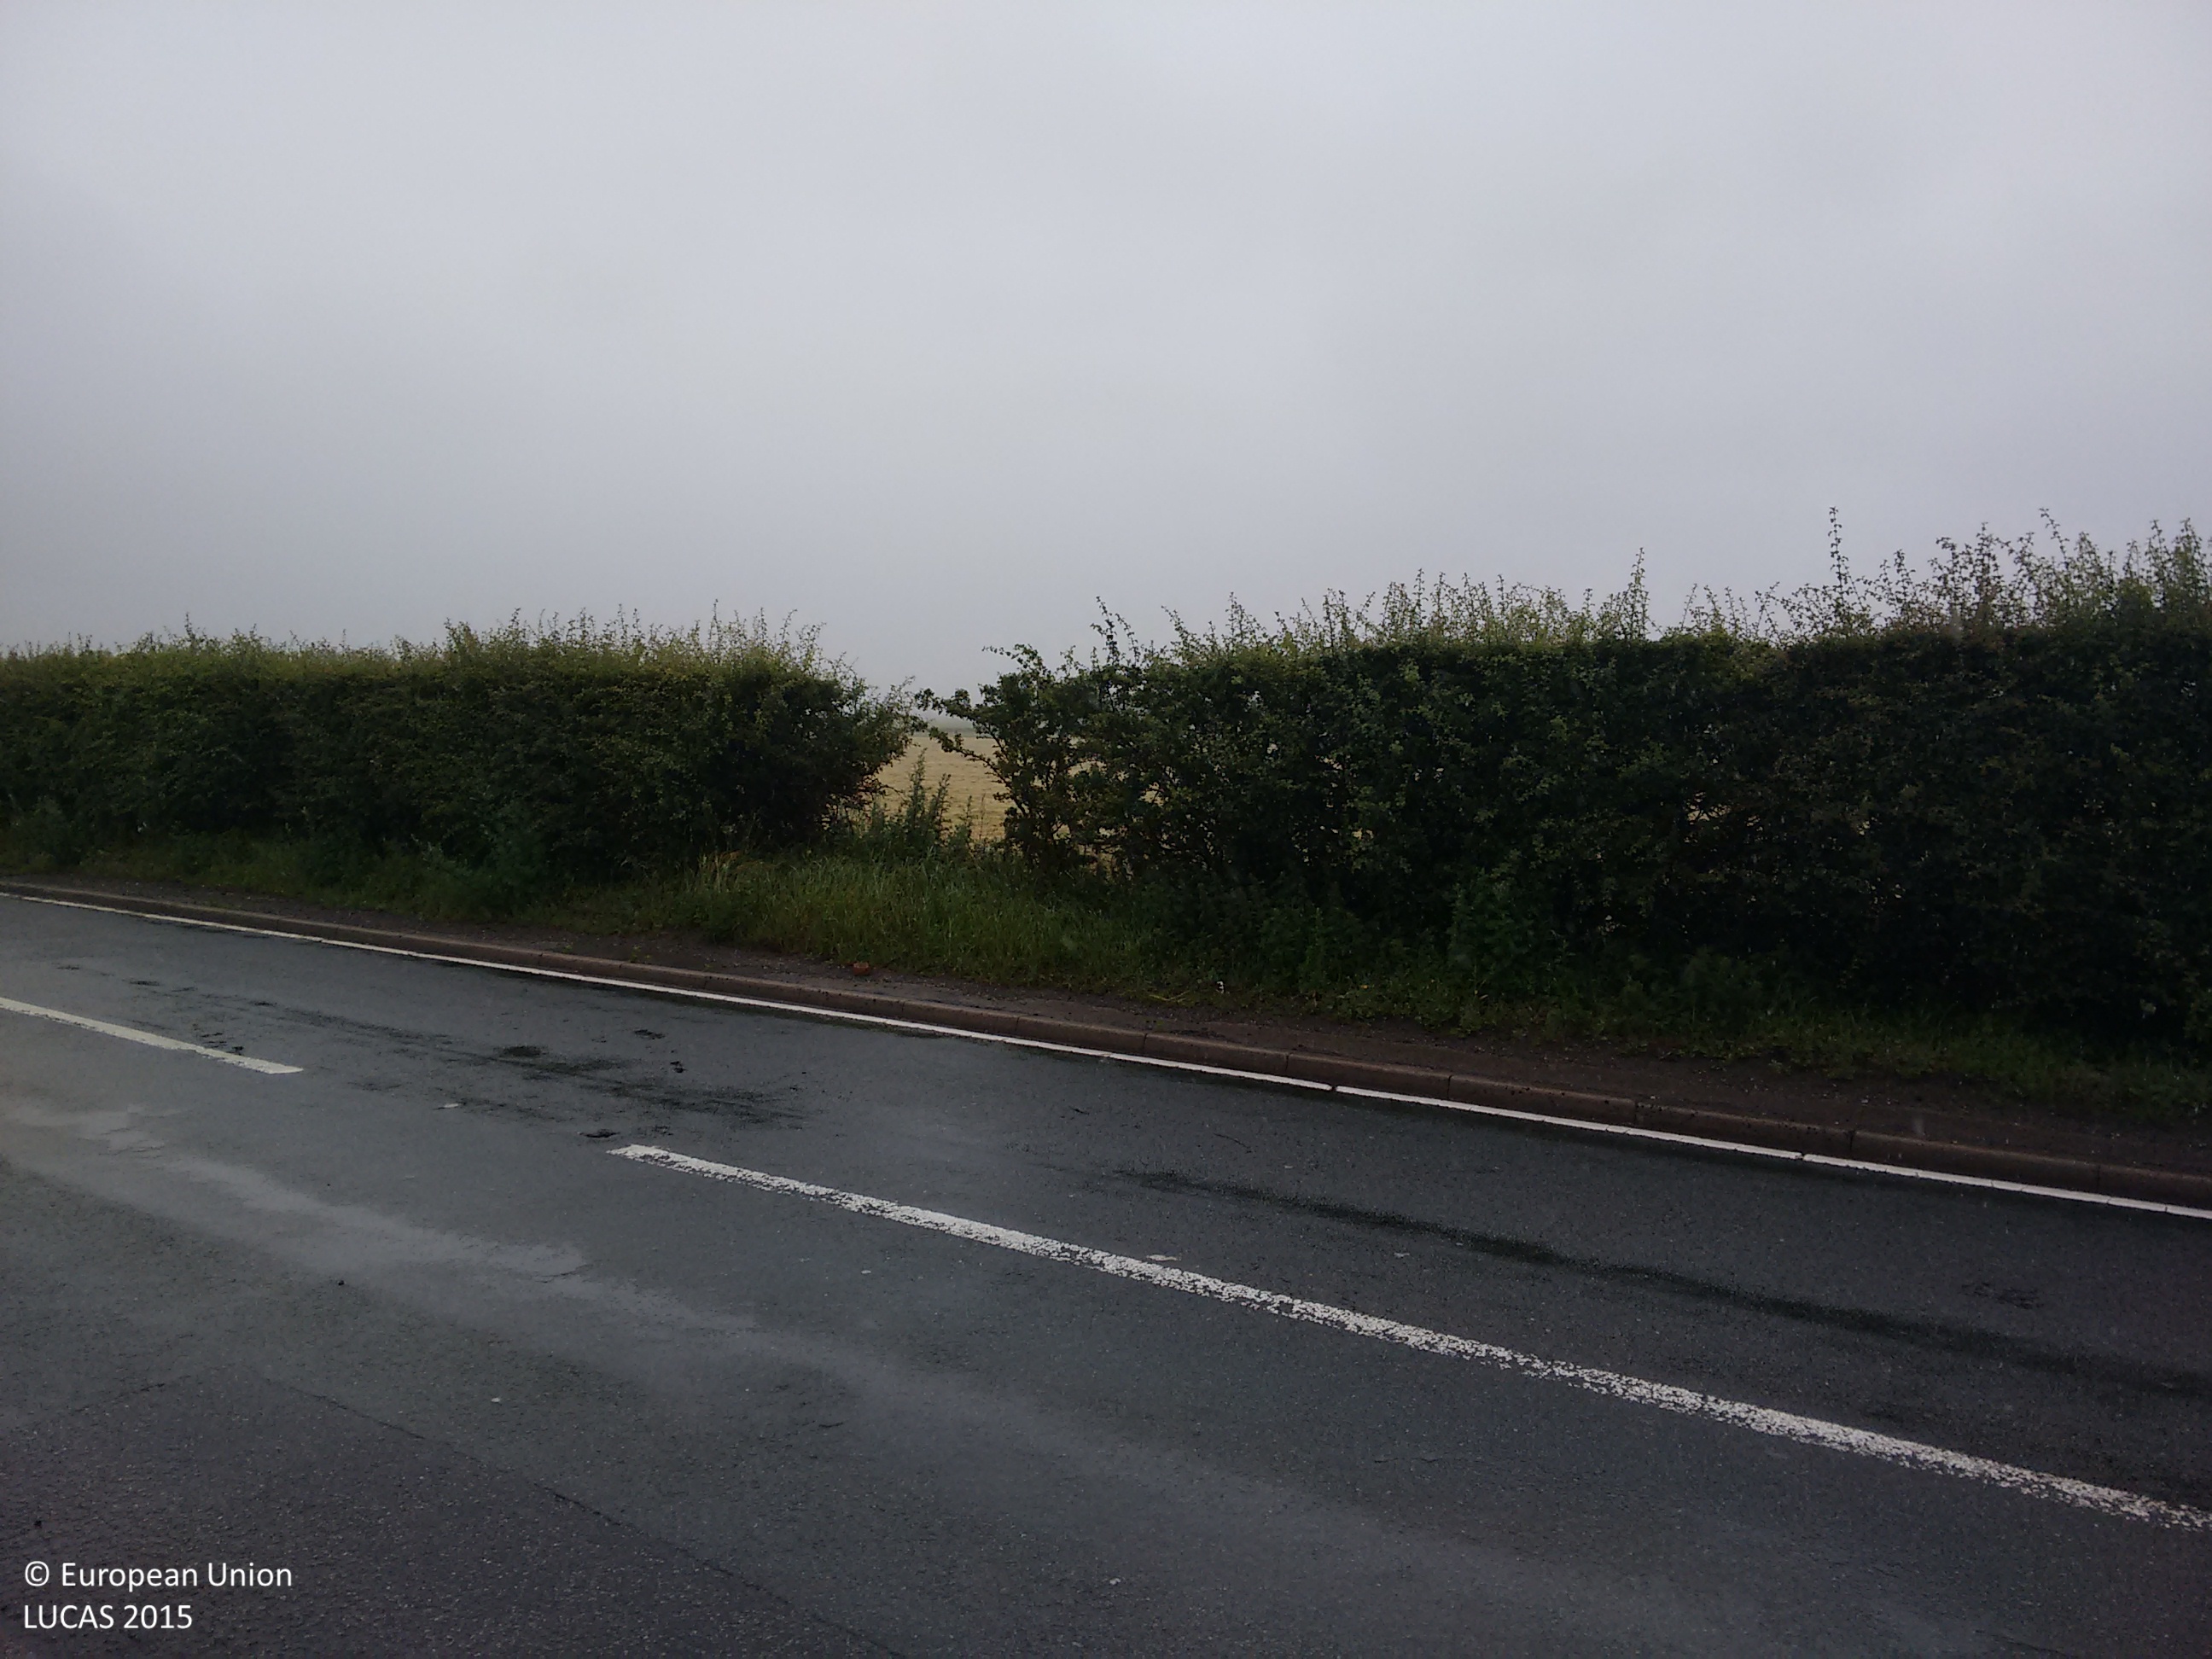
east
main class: Cropland
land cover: Potatoes
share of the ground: > 75 %
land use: Agriculture (excluding fallow land and kitchen gardens)
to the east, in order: Potatoes; Grass margins; Tracks; Other bare soil; Grass margins; Electric lines; Paved roads, cycling and walking lanes; Grass margins; Fences; Grassland without tree/shrub cover
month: July
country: GB
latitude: 53.4836
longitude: -2.8046
